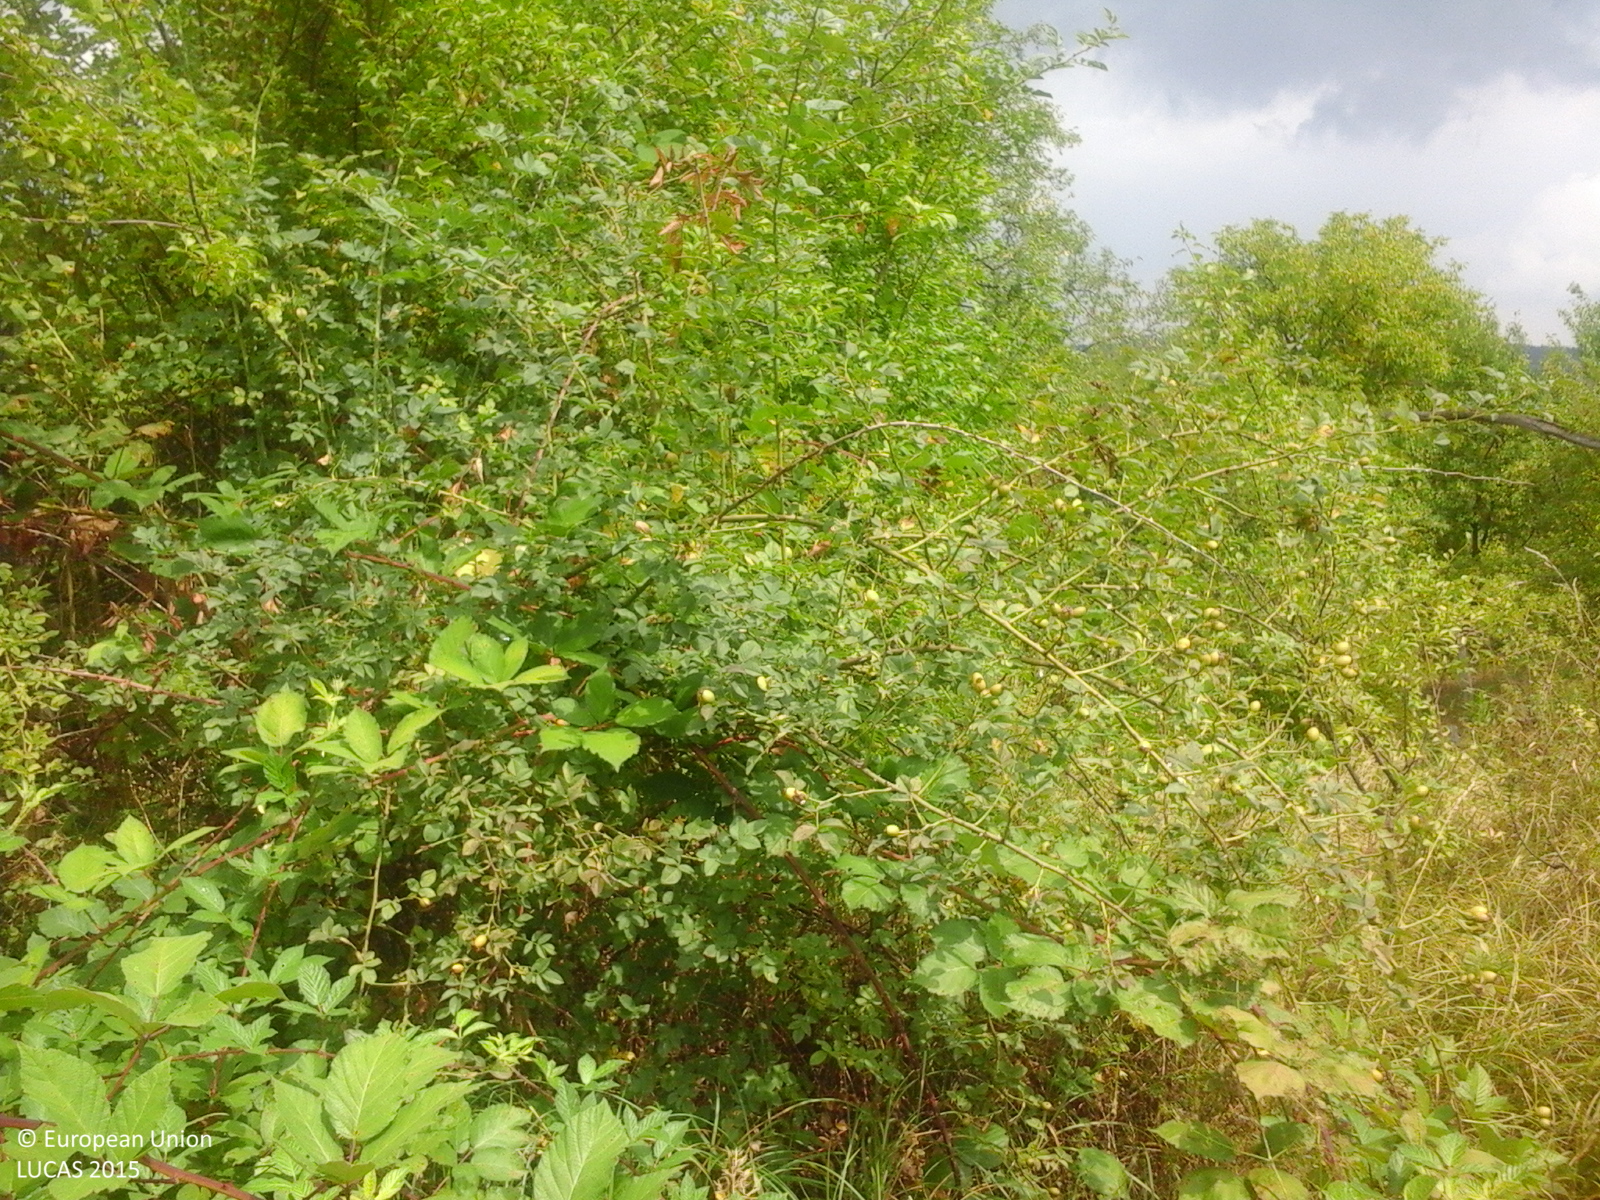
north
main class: Shrubland
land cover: Shrubland with sparse tree cover
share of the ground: > 75 %
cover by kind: shrubs 85 %, herbaceous plants 10 %, broadleaved forest trees 5 %
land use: Fallow land
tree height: > 5 m
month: August
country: RO
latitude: 44.8478
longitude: 22.8116
